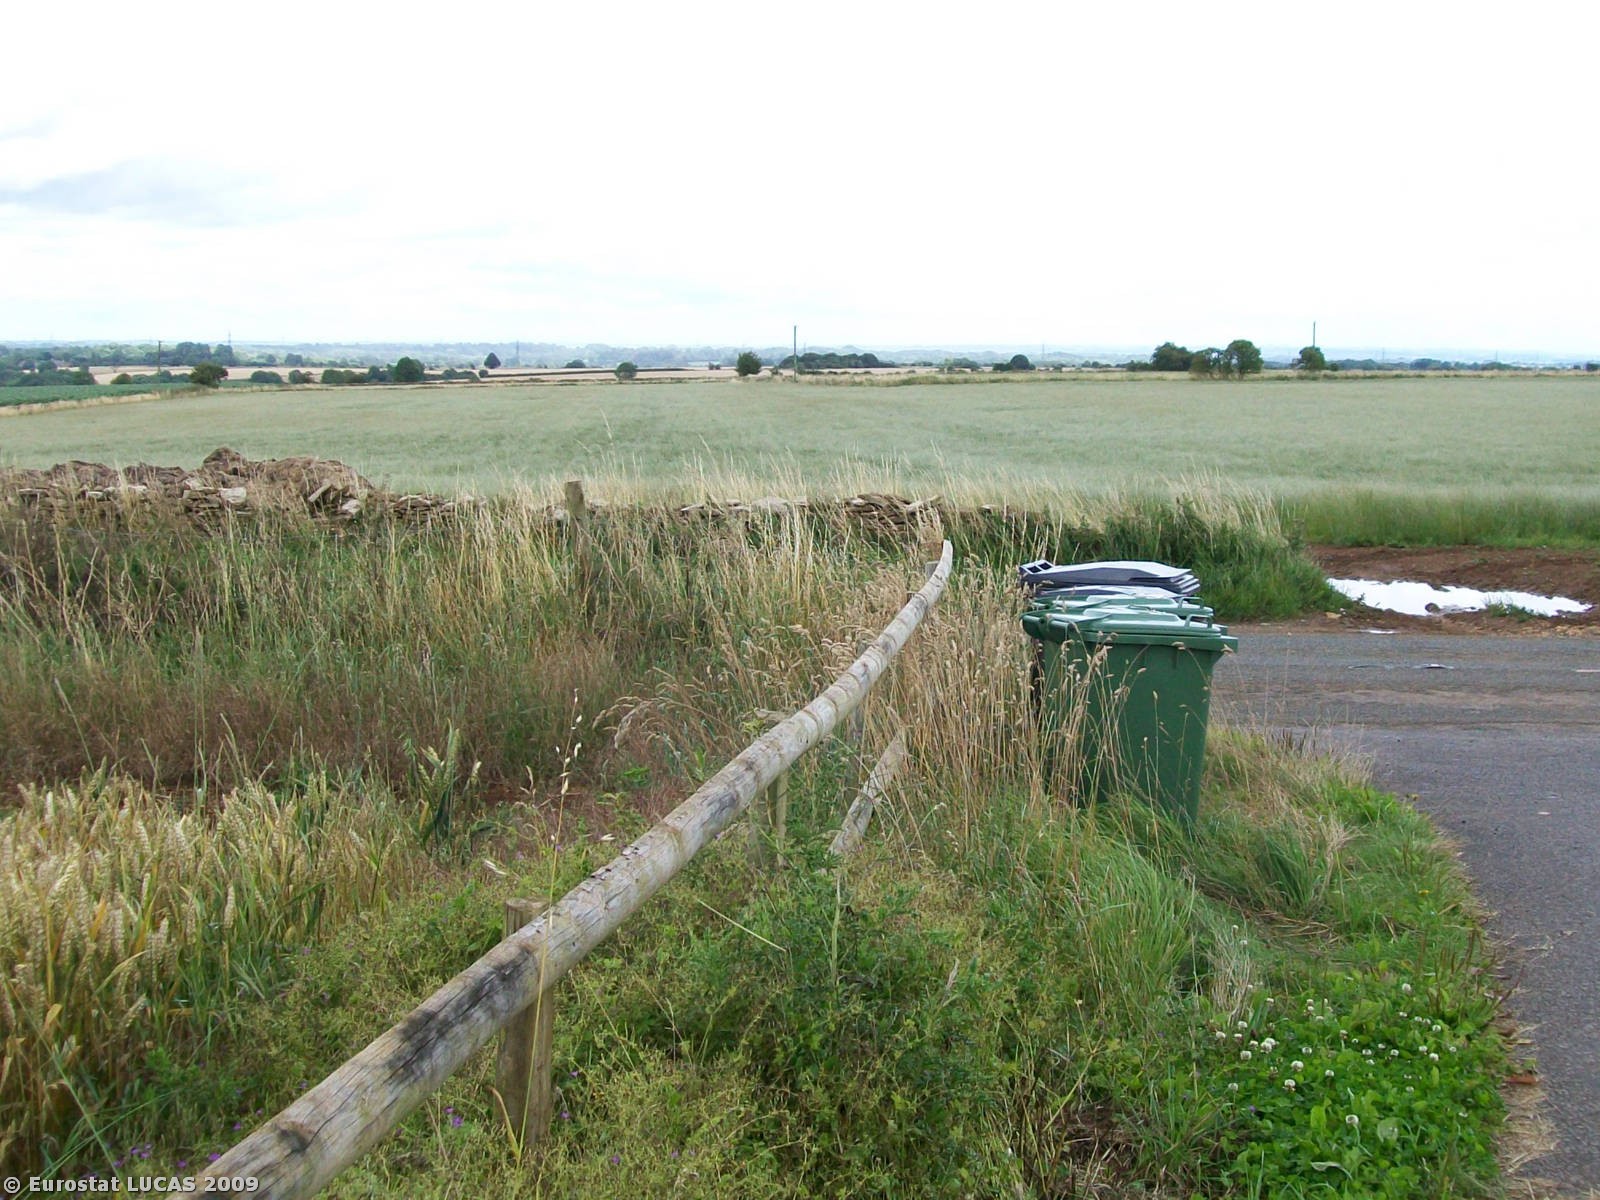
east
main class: Cropland
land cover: Barley
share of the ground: > 75 %
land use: Agriculture (excluding fallow land and kitchen gardens)
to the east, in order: Barley; Dry stone walls; Grass margins; Dry stone walls; Barley
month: July
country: GB
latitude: 51.4783
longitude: -2.3167
